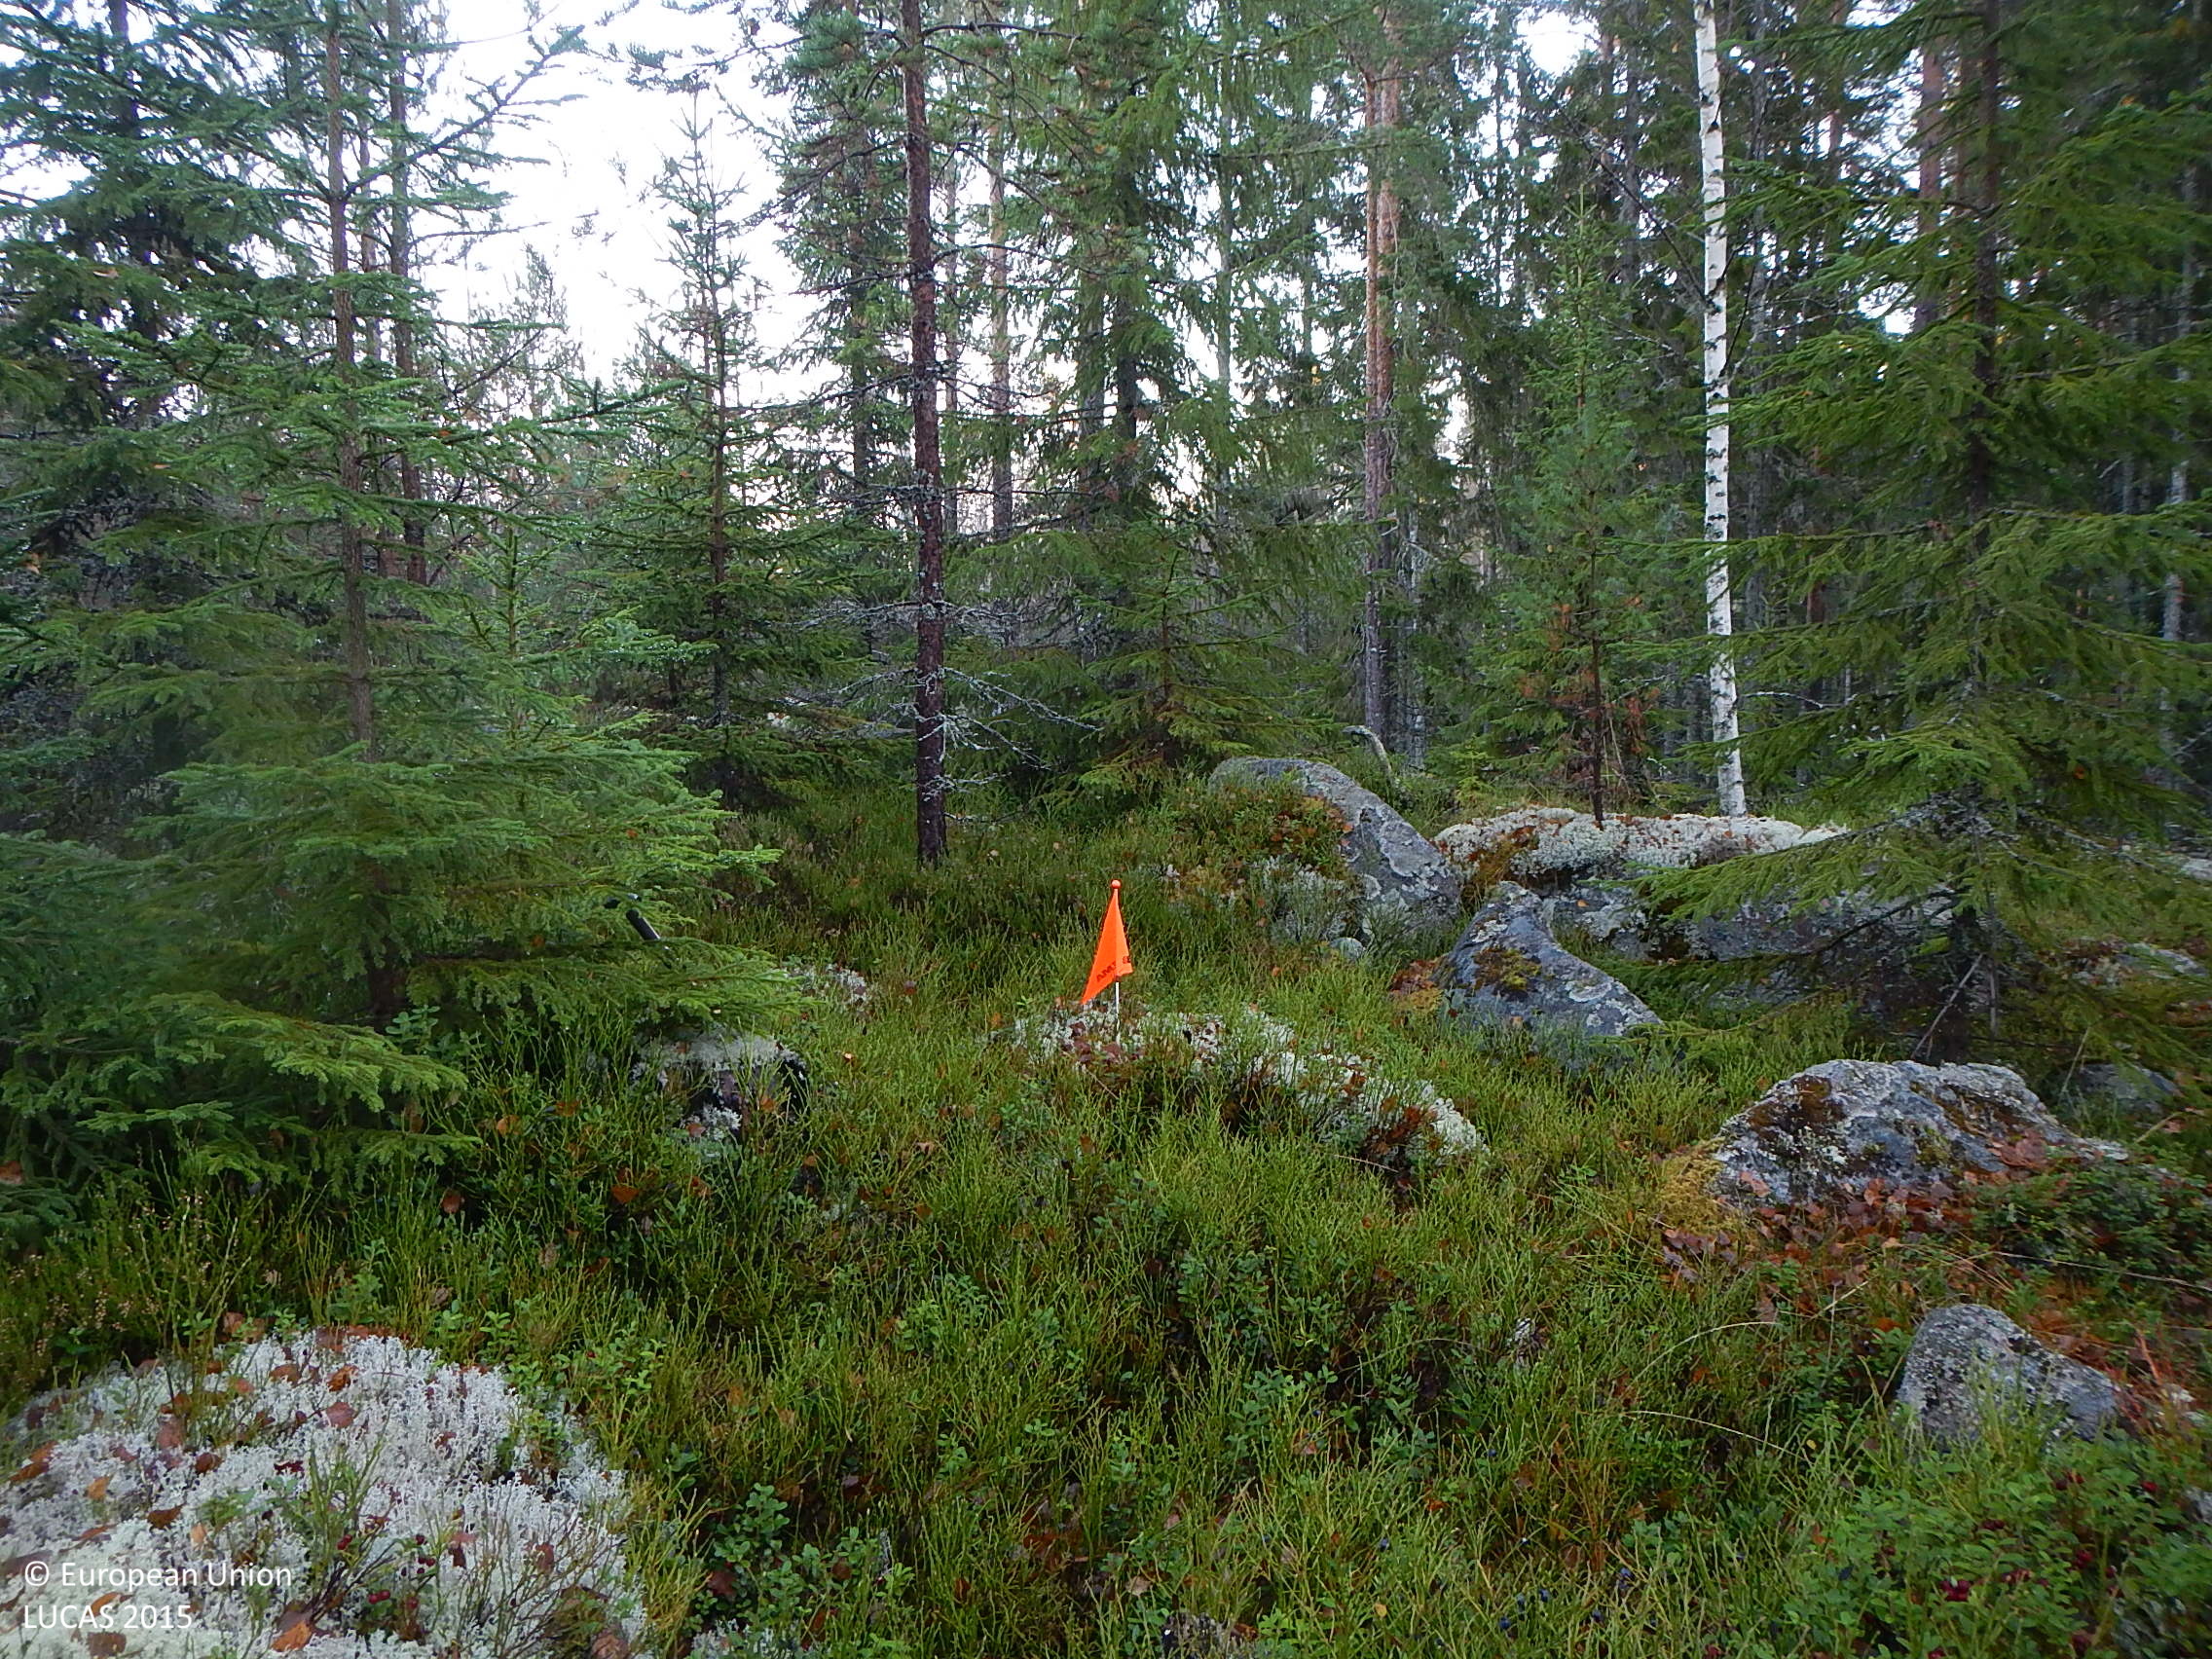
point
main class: Woodland
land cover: Other mixed woodland
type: boreal forest
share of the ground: 50 - 75 %
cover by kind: coniferous forest trees 40 %, shrubs 25 %, broadleaved forest trees 20 %, consolidated bare surface 10 %, lichens and mosses 5 %
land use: Forestry
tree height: > 5 m
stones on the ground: 10 - 25 %
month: November
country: SE
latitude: 61.2005
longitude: 17.0015
